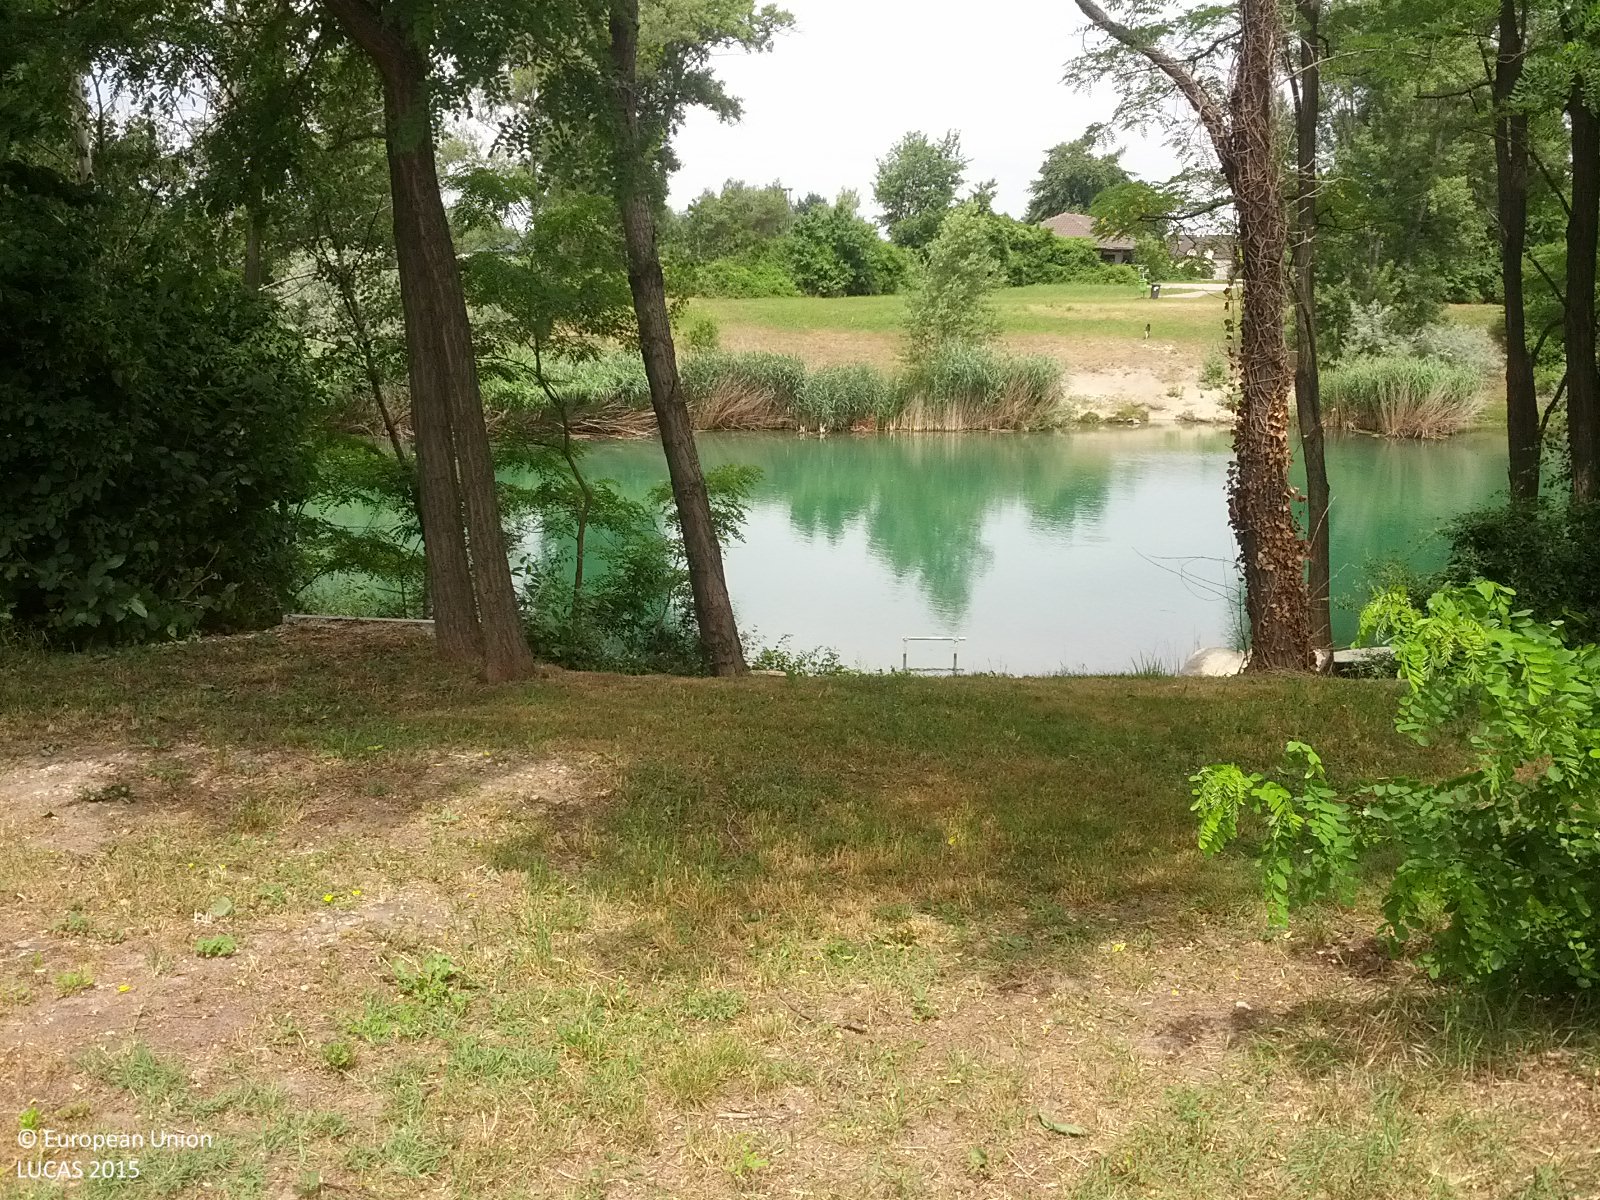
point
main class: Woodland
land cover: Broadleaved woodland
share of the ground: 25 - 50 %
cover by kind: herbaceous plants 60 %, broadleaved forest trees 35 %, shrubs 5 %
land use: Amenities, museums, leisure
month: June
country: AT
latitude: 48.1908
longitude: 16.5569
